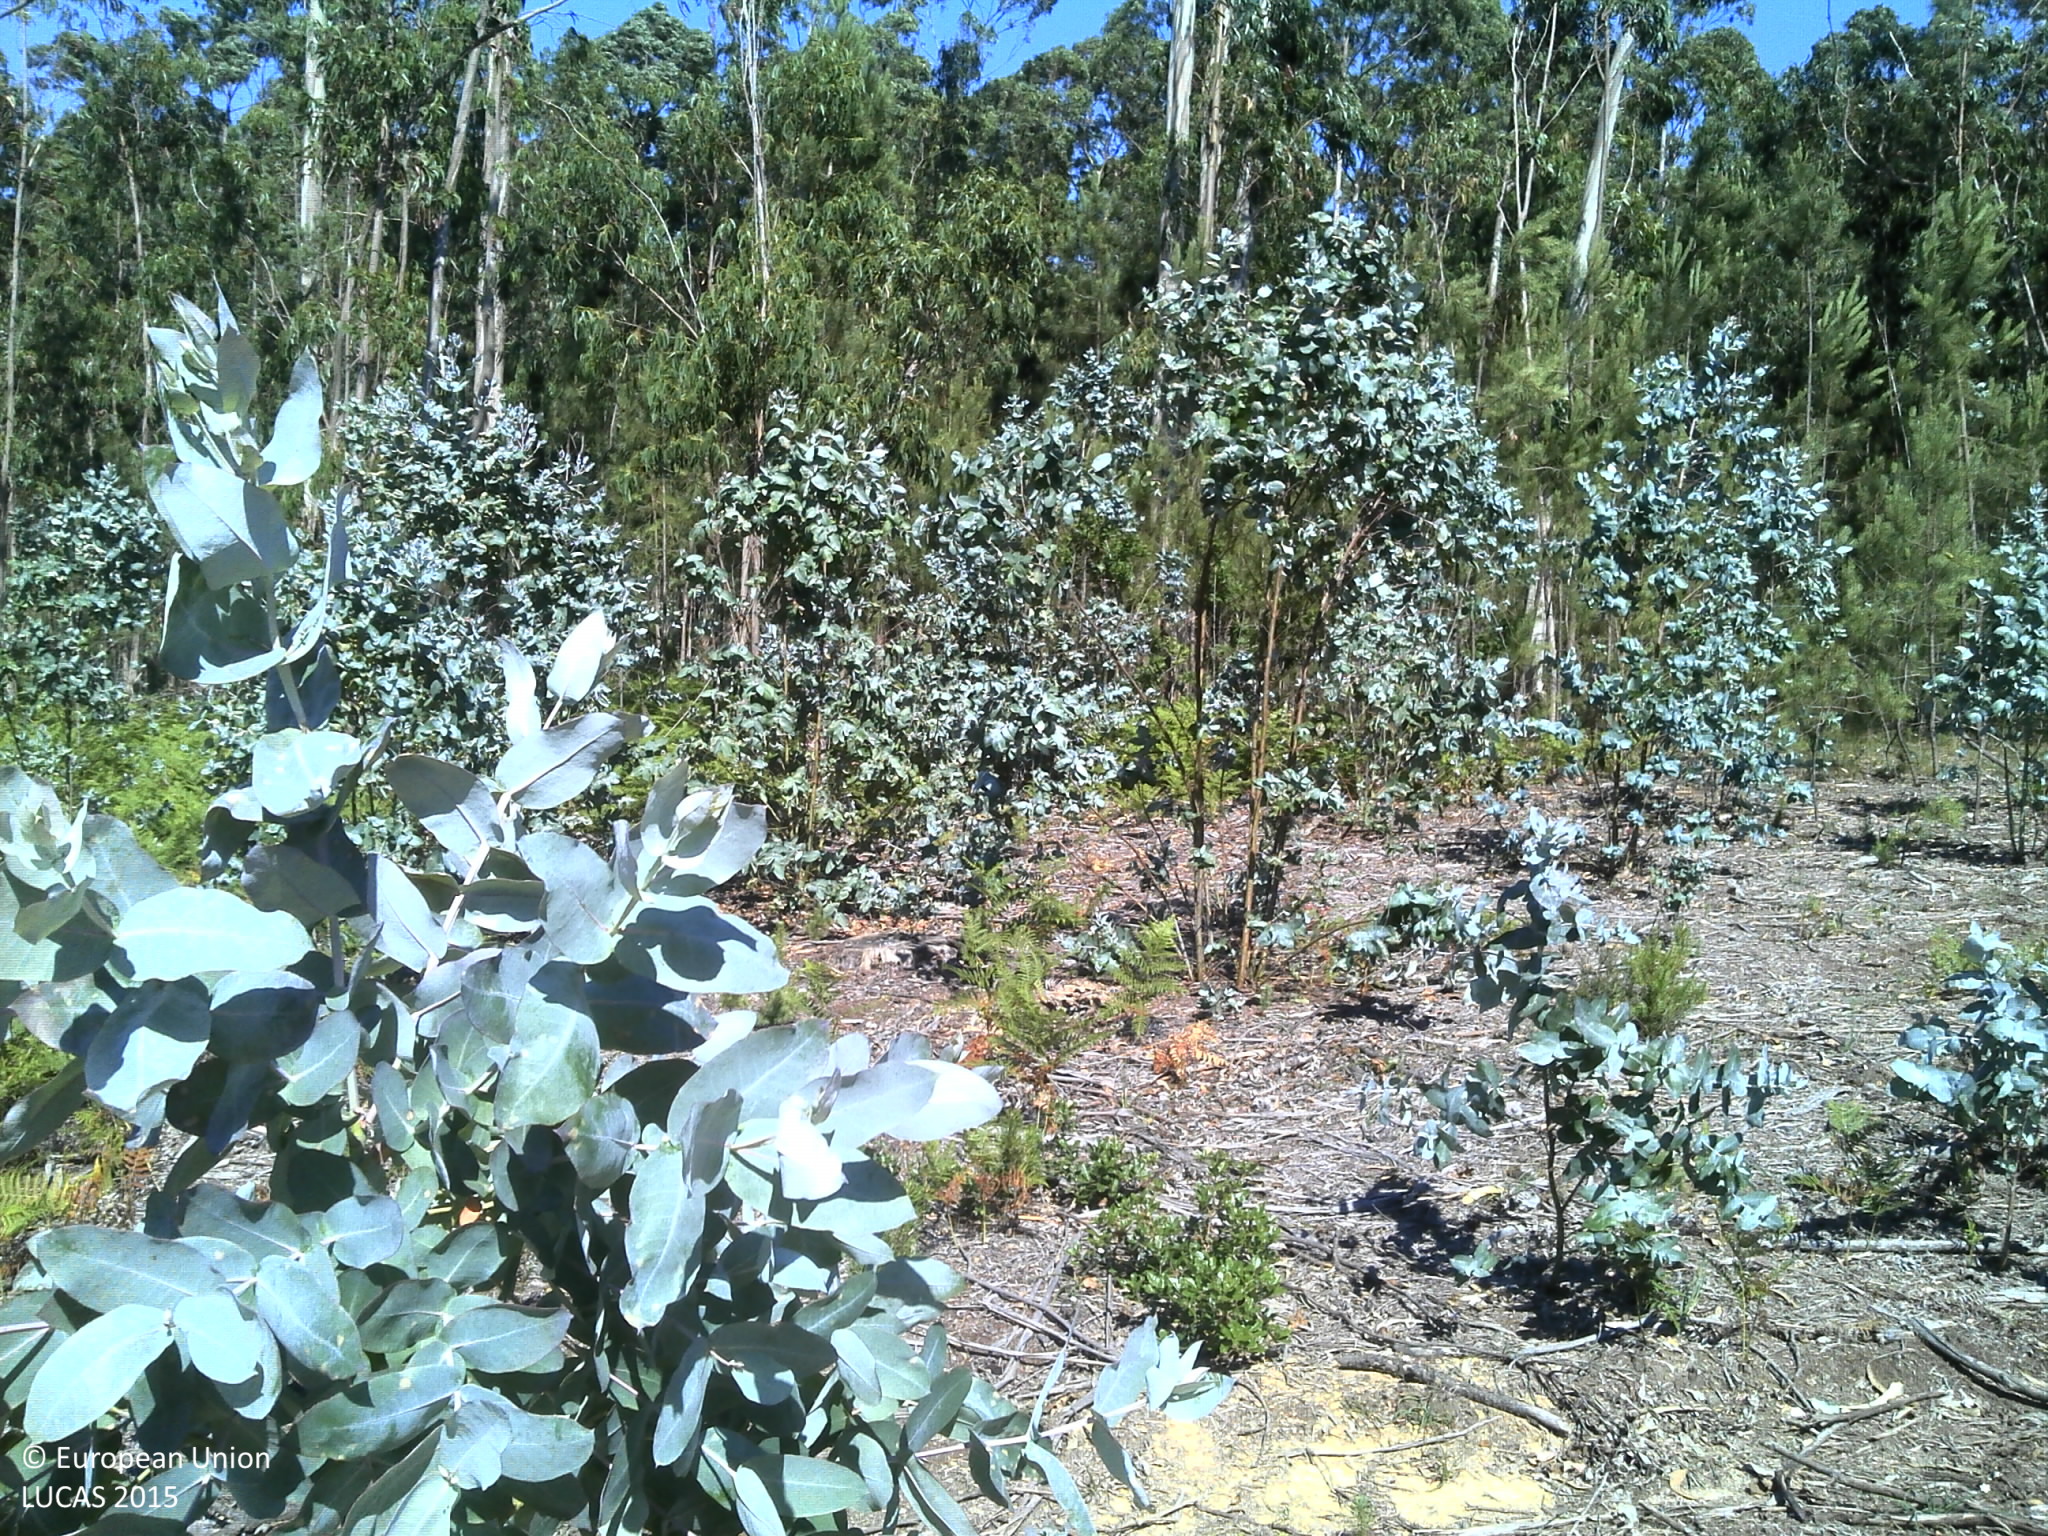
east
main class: Woodland
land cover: Broadleaved woodland
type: exotic forest
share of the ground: 25 - 50 %
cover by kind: unconsolidated bare surface 65 %, broadleaved forest trees 30 %, herbaceous plants 5 %
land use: Forestry
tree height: < 5 m
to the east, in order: Broadleaved woodland; Pine dominated mixed woodland; Broadleaved woodland
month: June
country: PT
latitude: 40.7320
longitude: -8.4827
